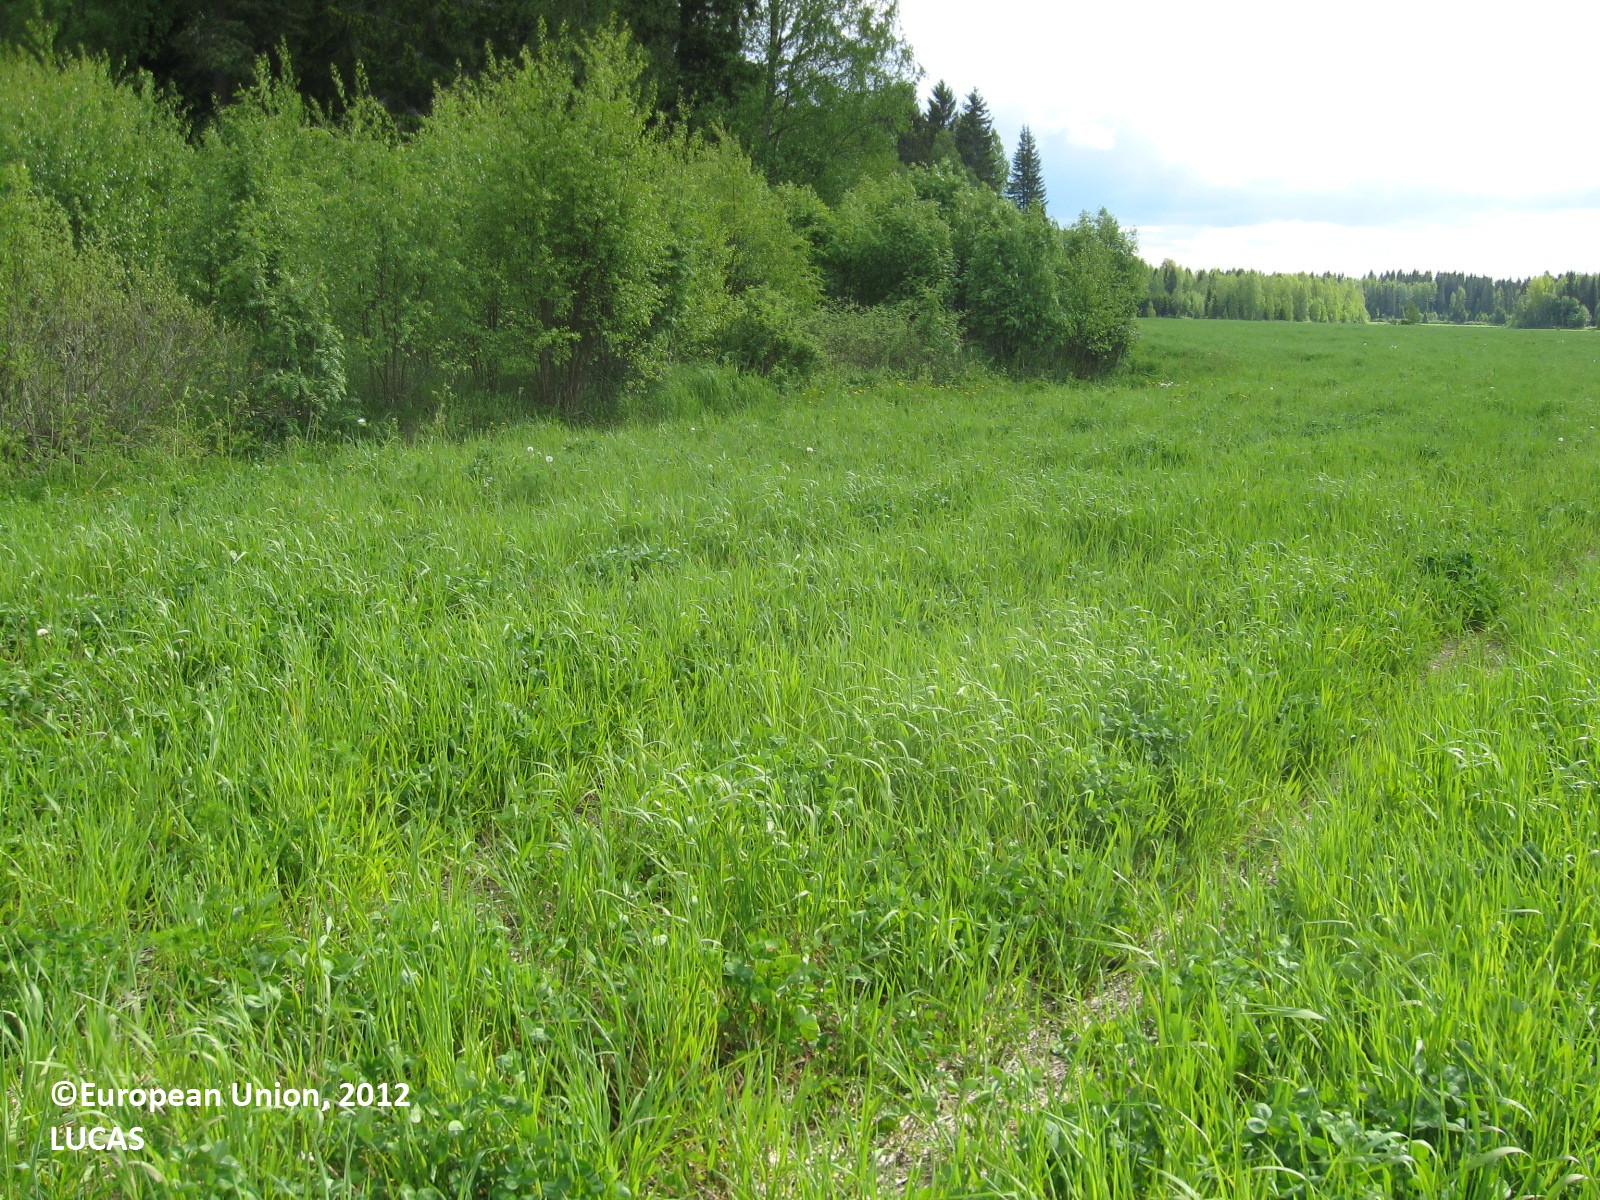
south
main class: Grassland
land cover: Grassland without tree/shrub cover
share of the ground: > 75 %
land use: Agriculture (excluding fallow land and kitchen gardens)
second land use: Energy production
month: June
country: FI
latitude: 63.0709
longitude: 21.8986
